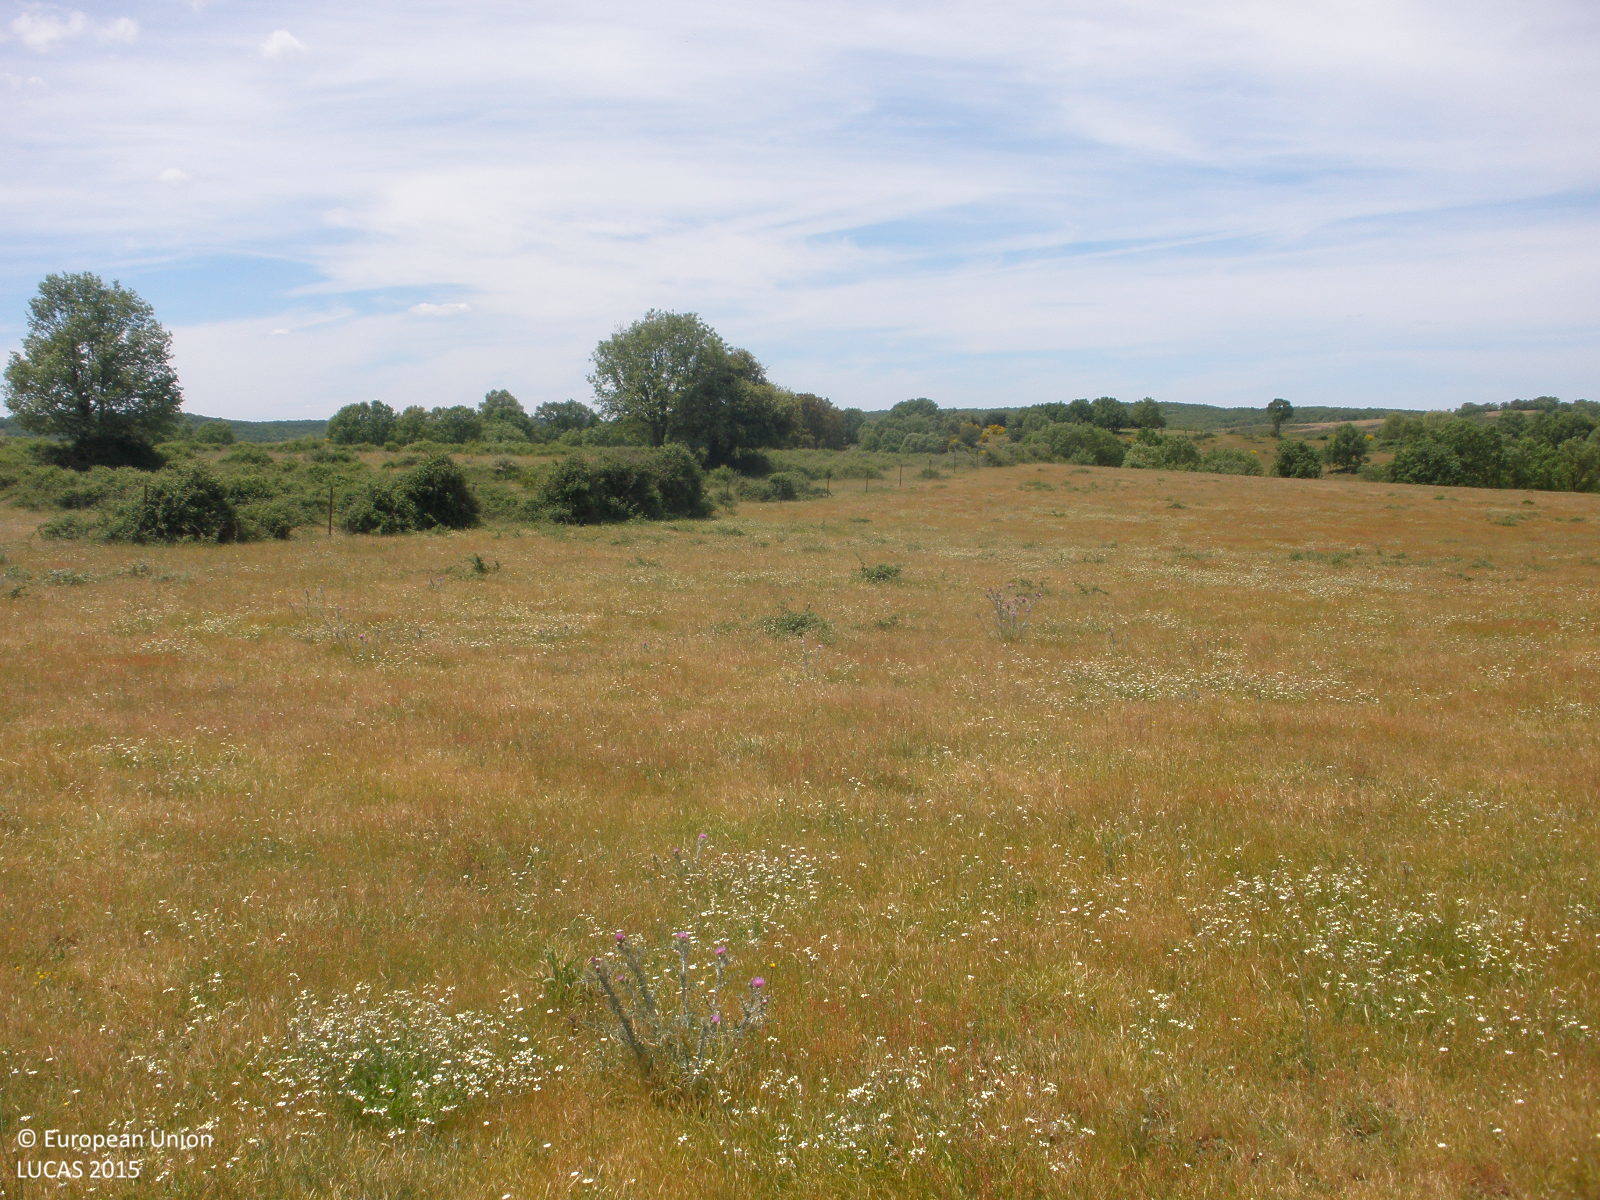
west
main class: Grassland
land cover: Grassland without tree/shrub cover
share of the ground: > 75 %
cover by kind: herbaceous plants 100 %
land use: Agriculture (excluding fallow land and kitchen gardens)
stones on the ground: < 10 %
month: May
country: ES
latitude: 40.3788
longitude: -6.6616
